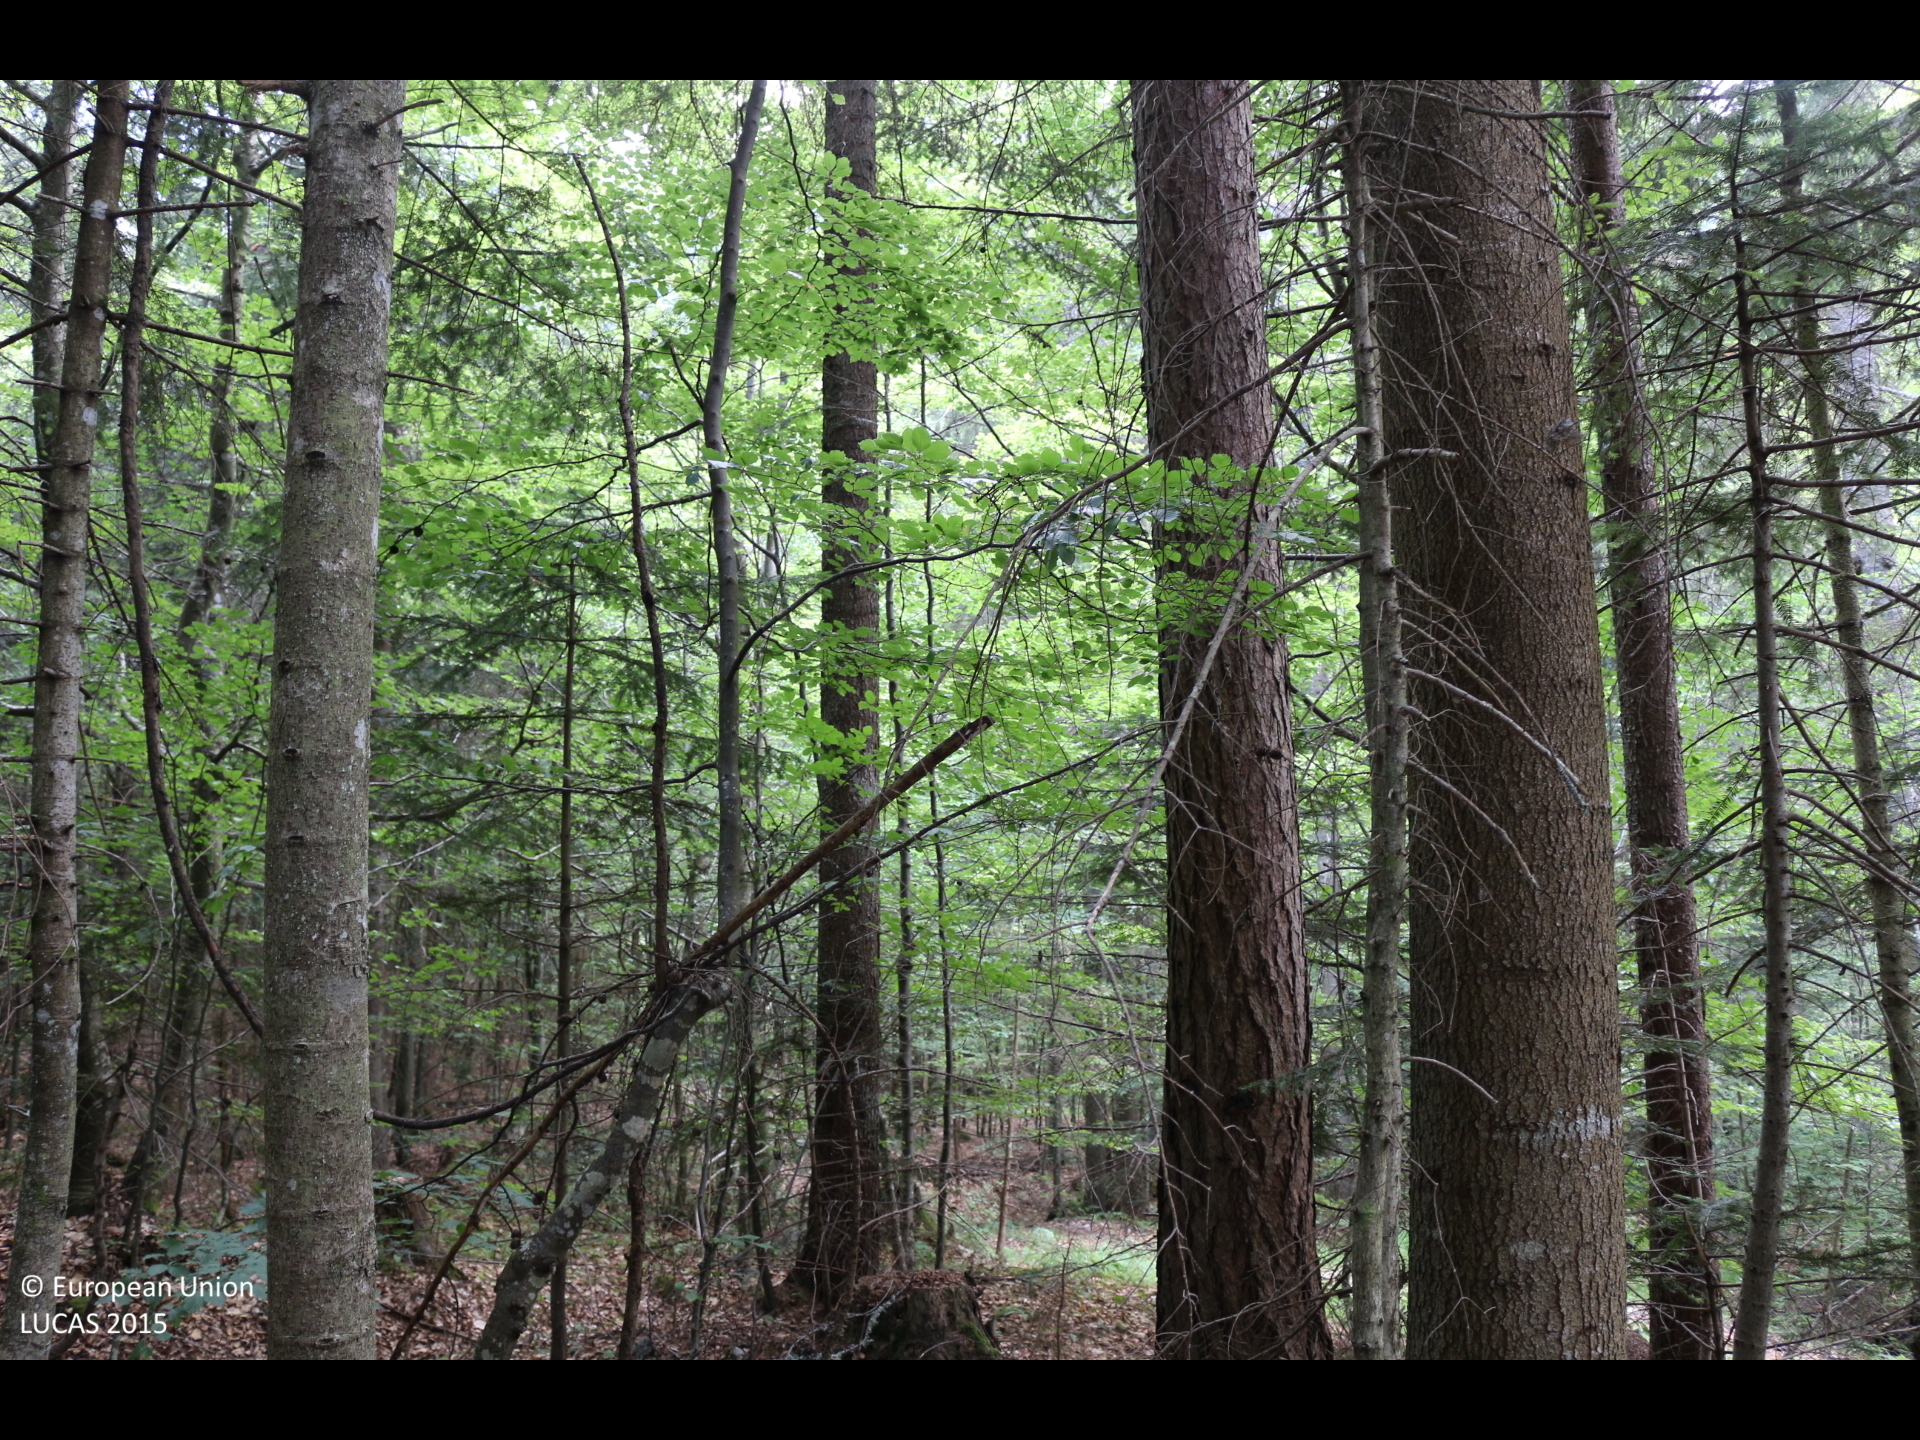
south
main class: Woodland
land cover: Spruce dominated mixed woodland
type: mountainous beech forest
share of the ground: > 75 %
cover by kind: broadleaved forest trees 60 %, coniferous forest trees 40 %
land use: Forestry
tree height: > 5 m
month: June
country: AT
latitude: 46.5308
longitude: 13.9475
